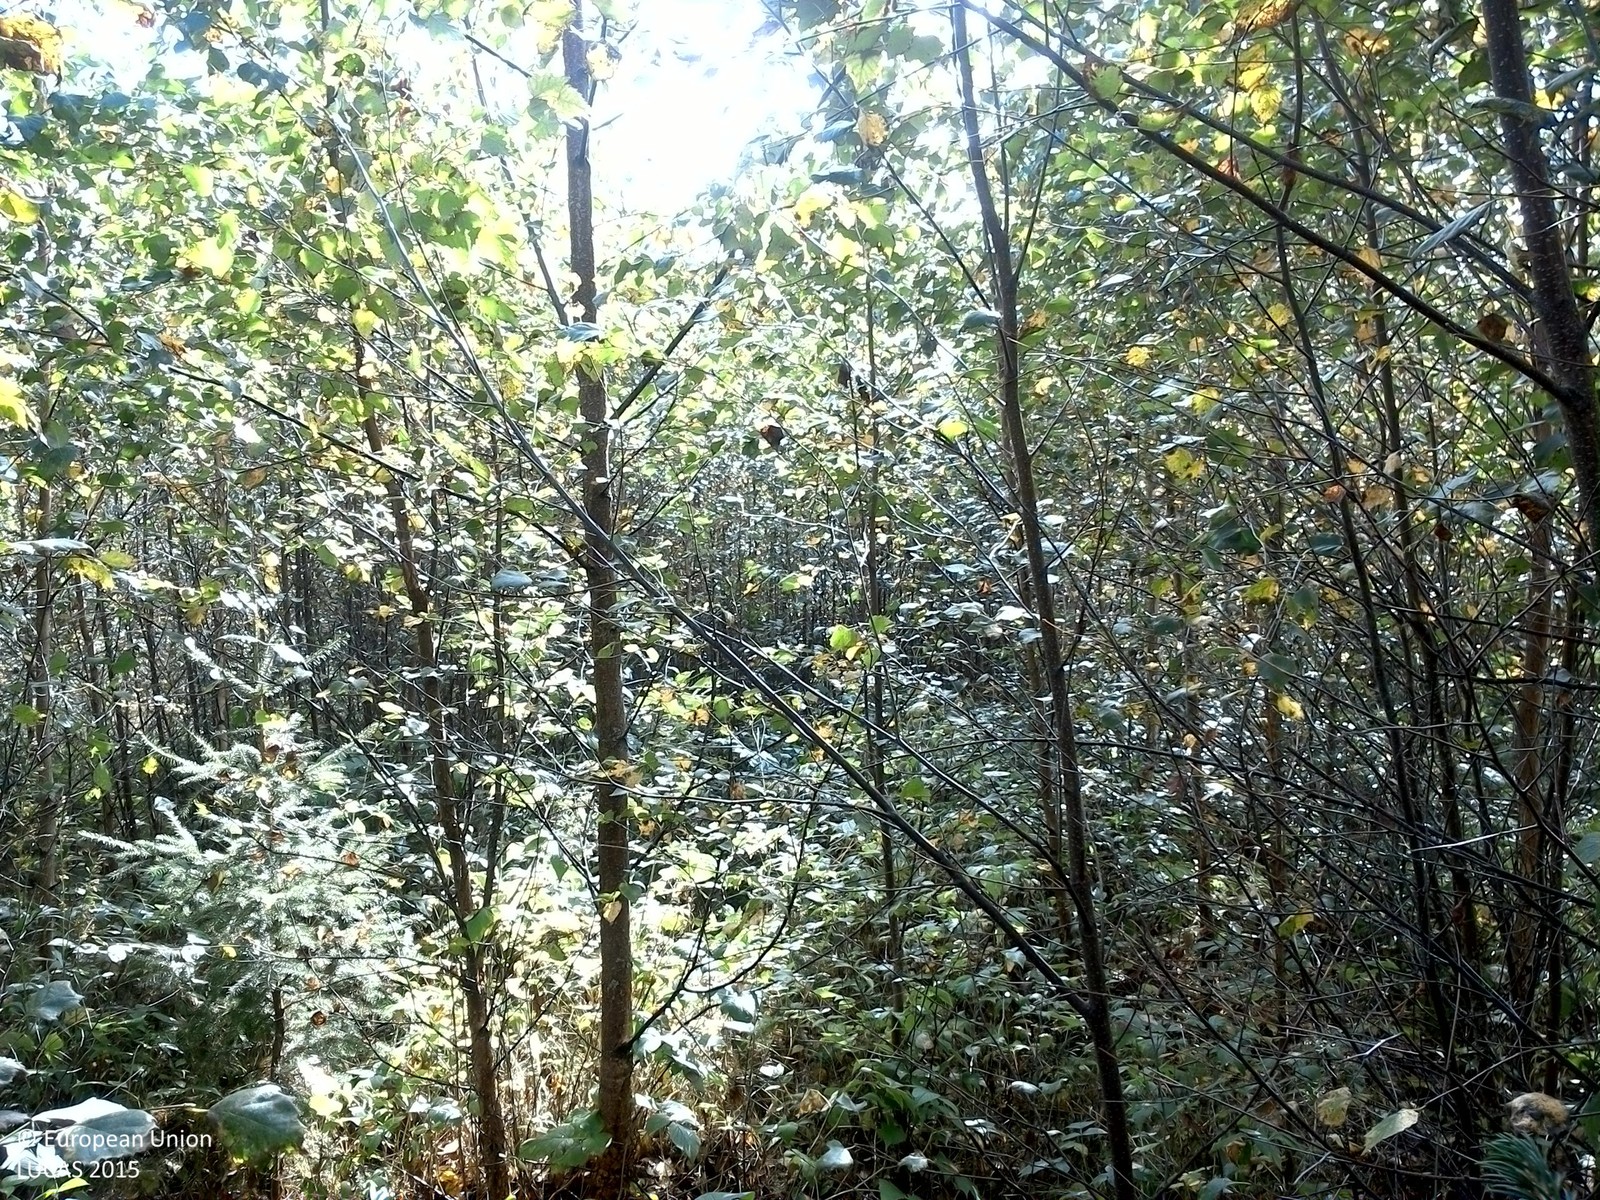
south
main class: Woodland
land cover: Spruce dominated mixed woodland
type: boreal forest
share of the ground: > 75 %
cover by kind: coniferous forest trees 40 %, broadleaved forest trees 35 %, herbaceous plants 10 %, consolidated bare surface 10 %, lichens and mosses 5 %
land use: Forestry
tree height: < 5 m
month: September
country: SE
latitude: 59.9283
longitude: 13.1941
